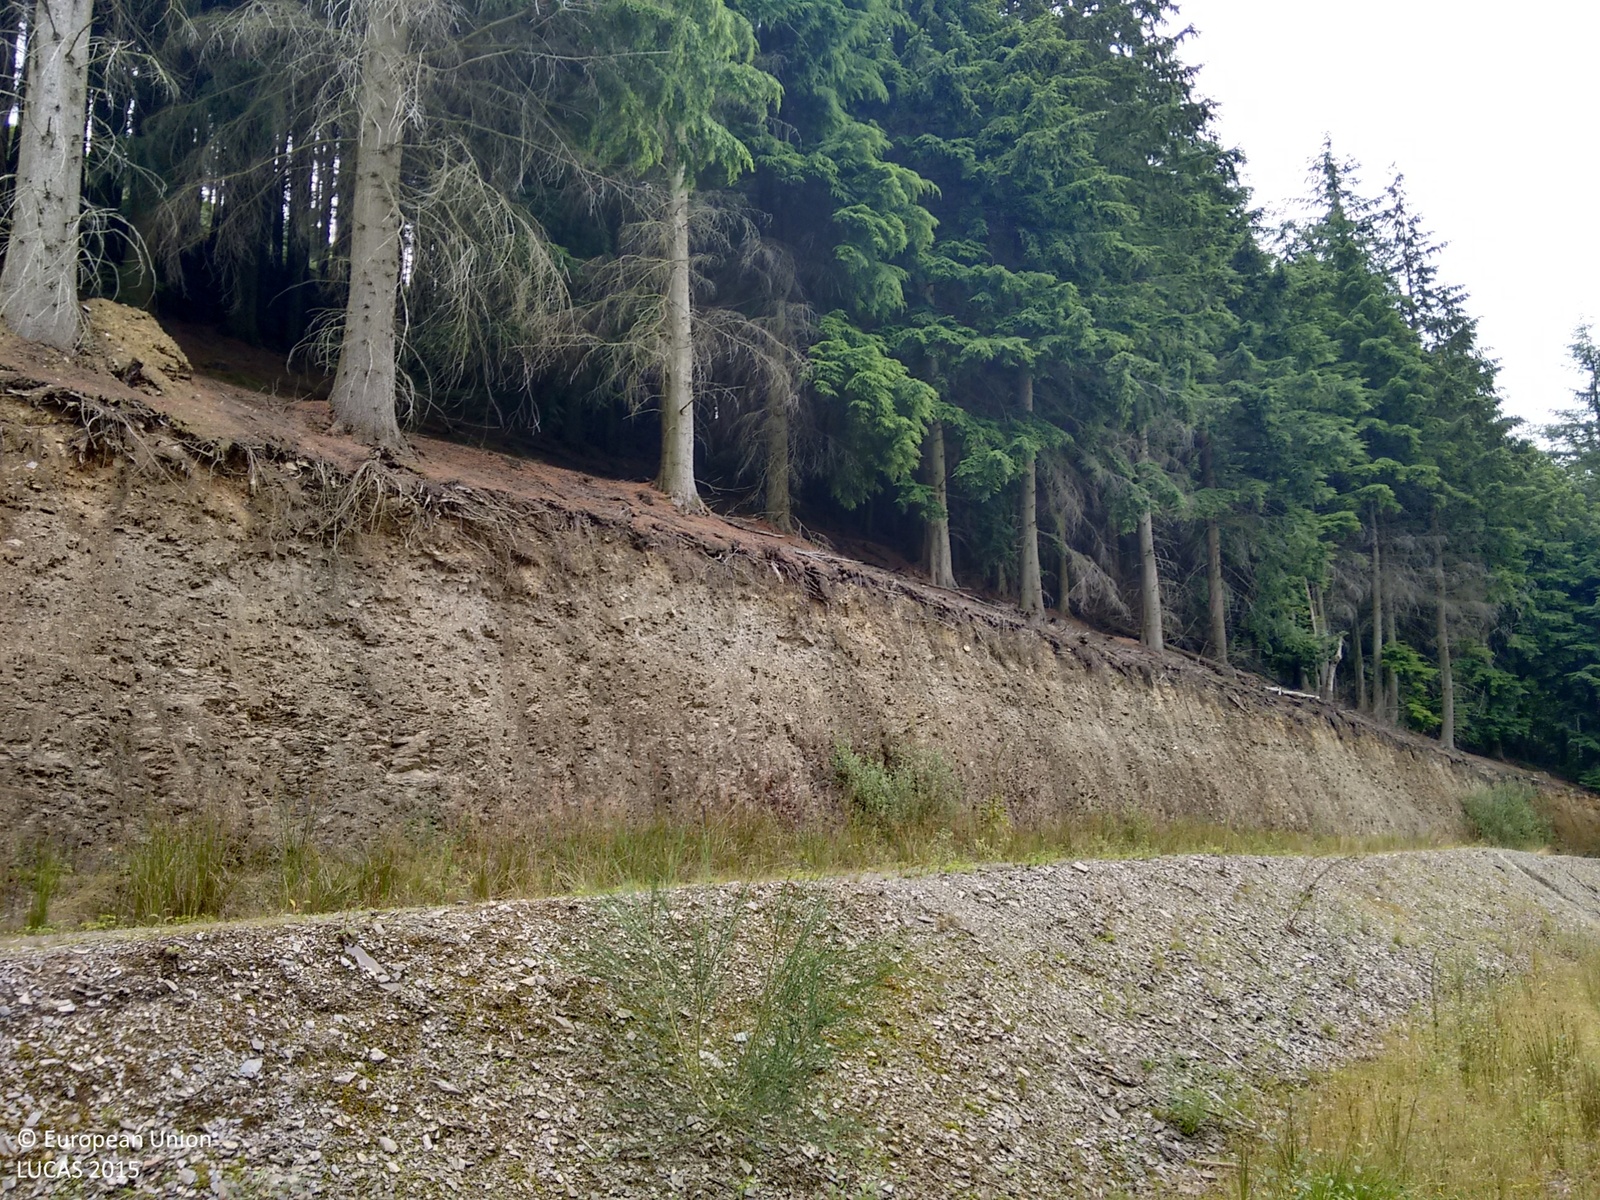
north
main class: Woodland
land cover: Spruce dominated coniferous woodland
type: exotic forest
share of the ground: > 75 %
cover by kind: coniferous forest trees 90 %, shrubs 10 %
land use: Forestry
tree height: > 5 m
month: August
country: GB
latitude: 52.0789
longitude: -3.9407
